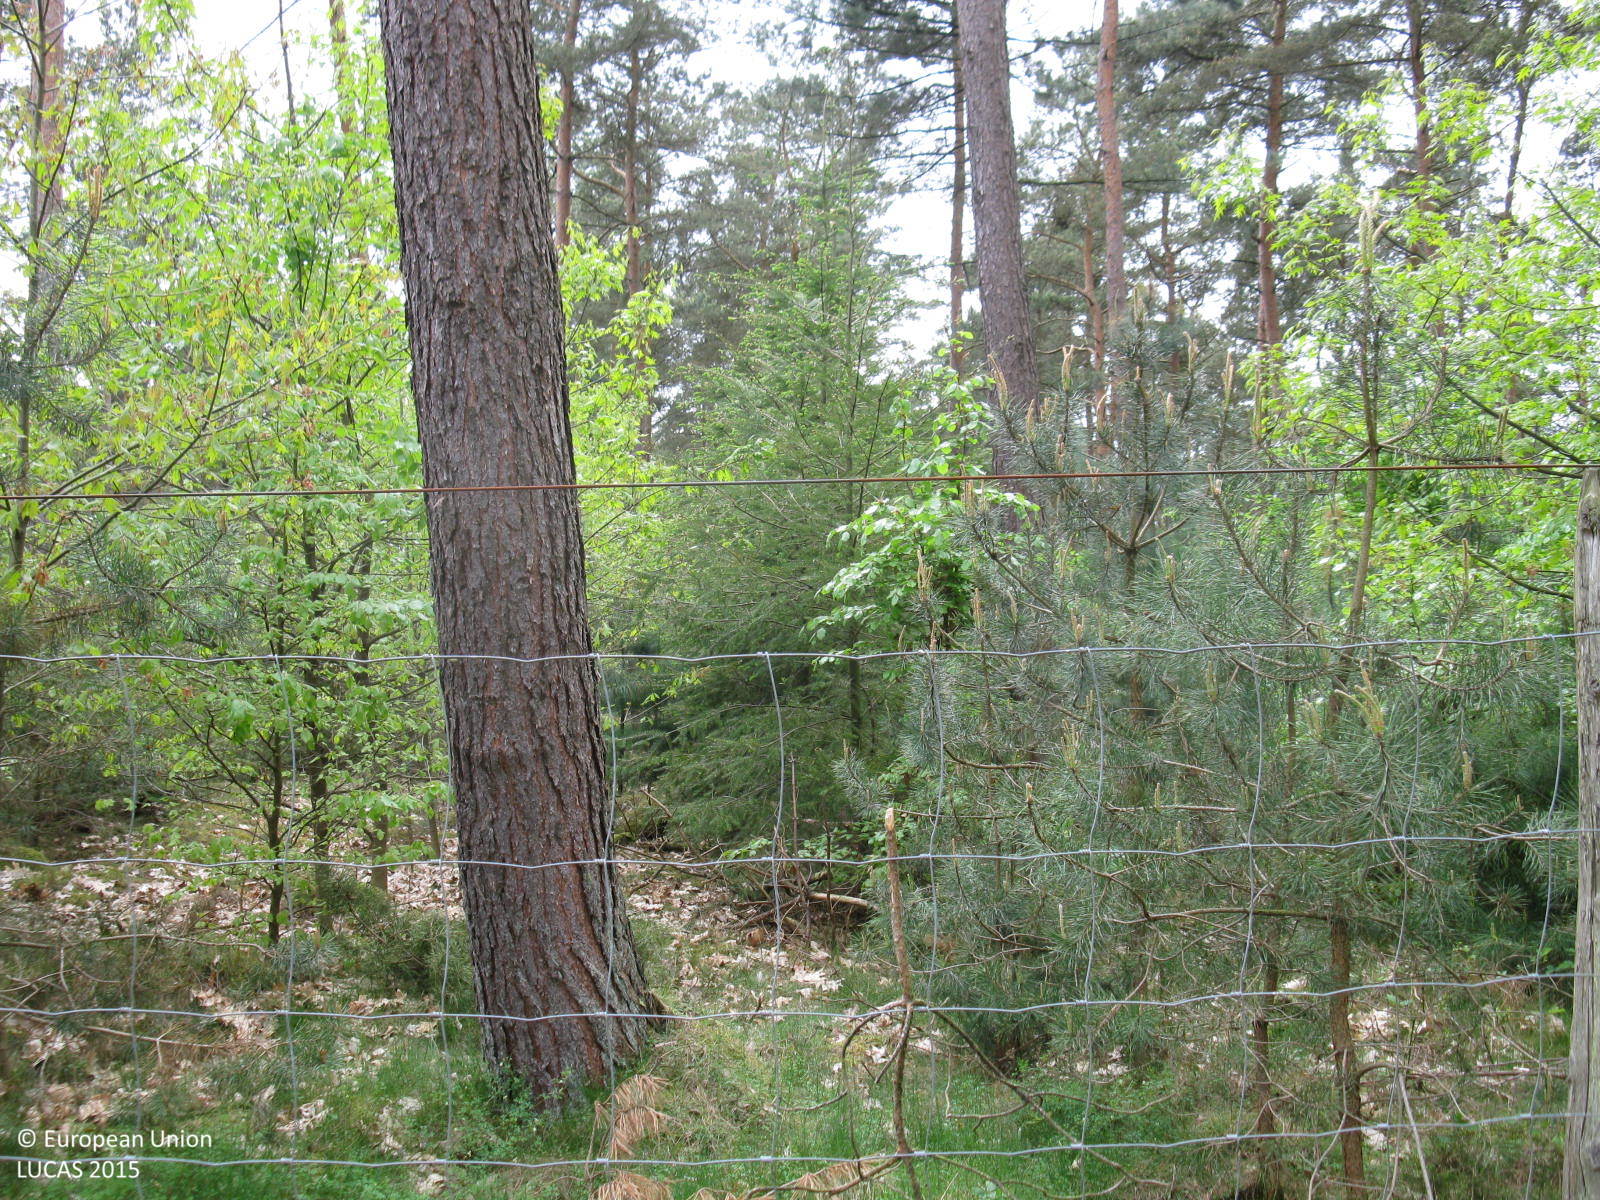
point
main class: Woodland
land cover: Pine dominated coniferous woodland
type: hemiboreal forest and nemoral coniferous forest and mixed broadleaved-coniferous forest
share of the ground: 50 - 75 %
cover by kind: coniferous forest trees 70 %, broadleaved forest trees 10 %, shrubs 10 %, herbaceous plants 10 %
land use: Forestry
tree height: > 5 m
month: May
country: DE
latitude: 52.8333
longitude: 7.3435
